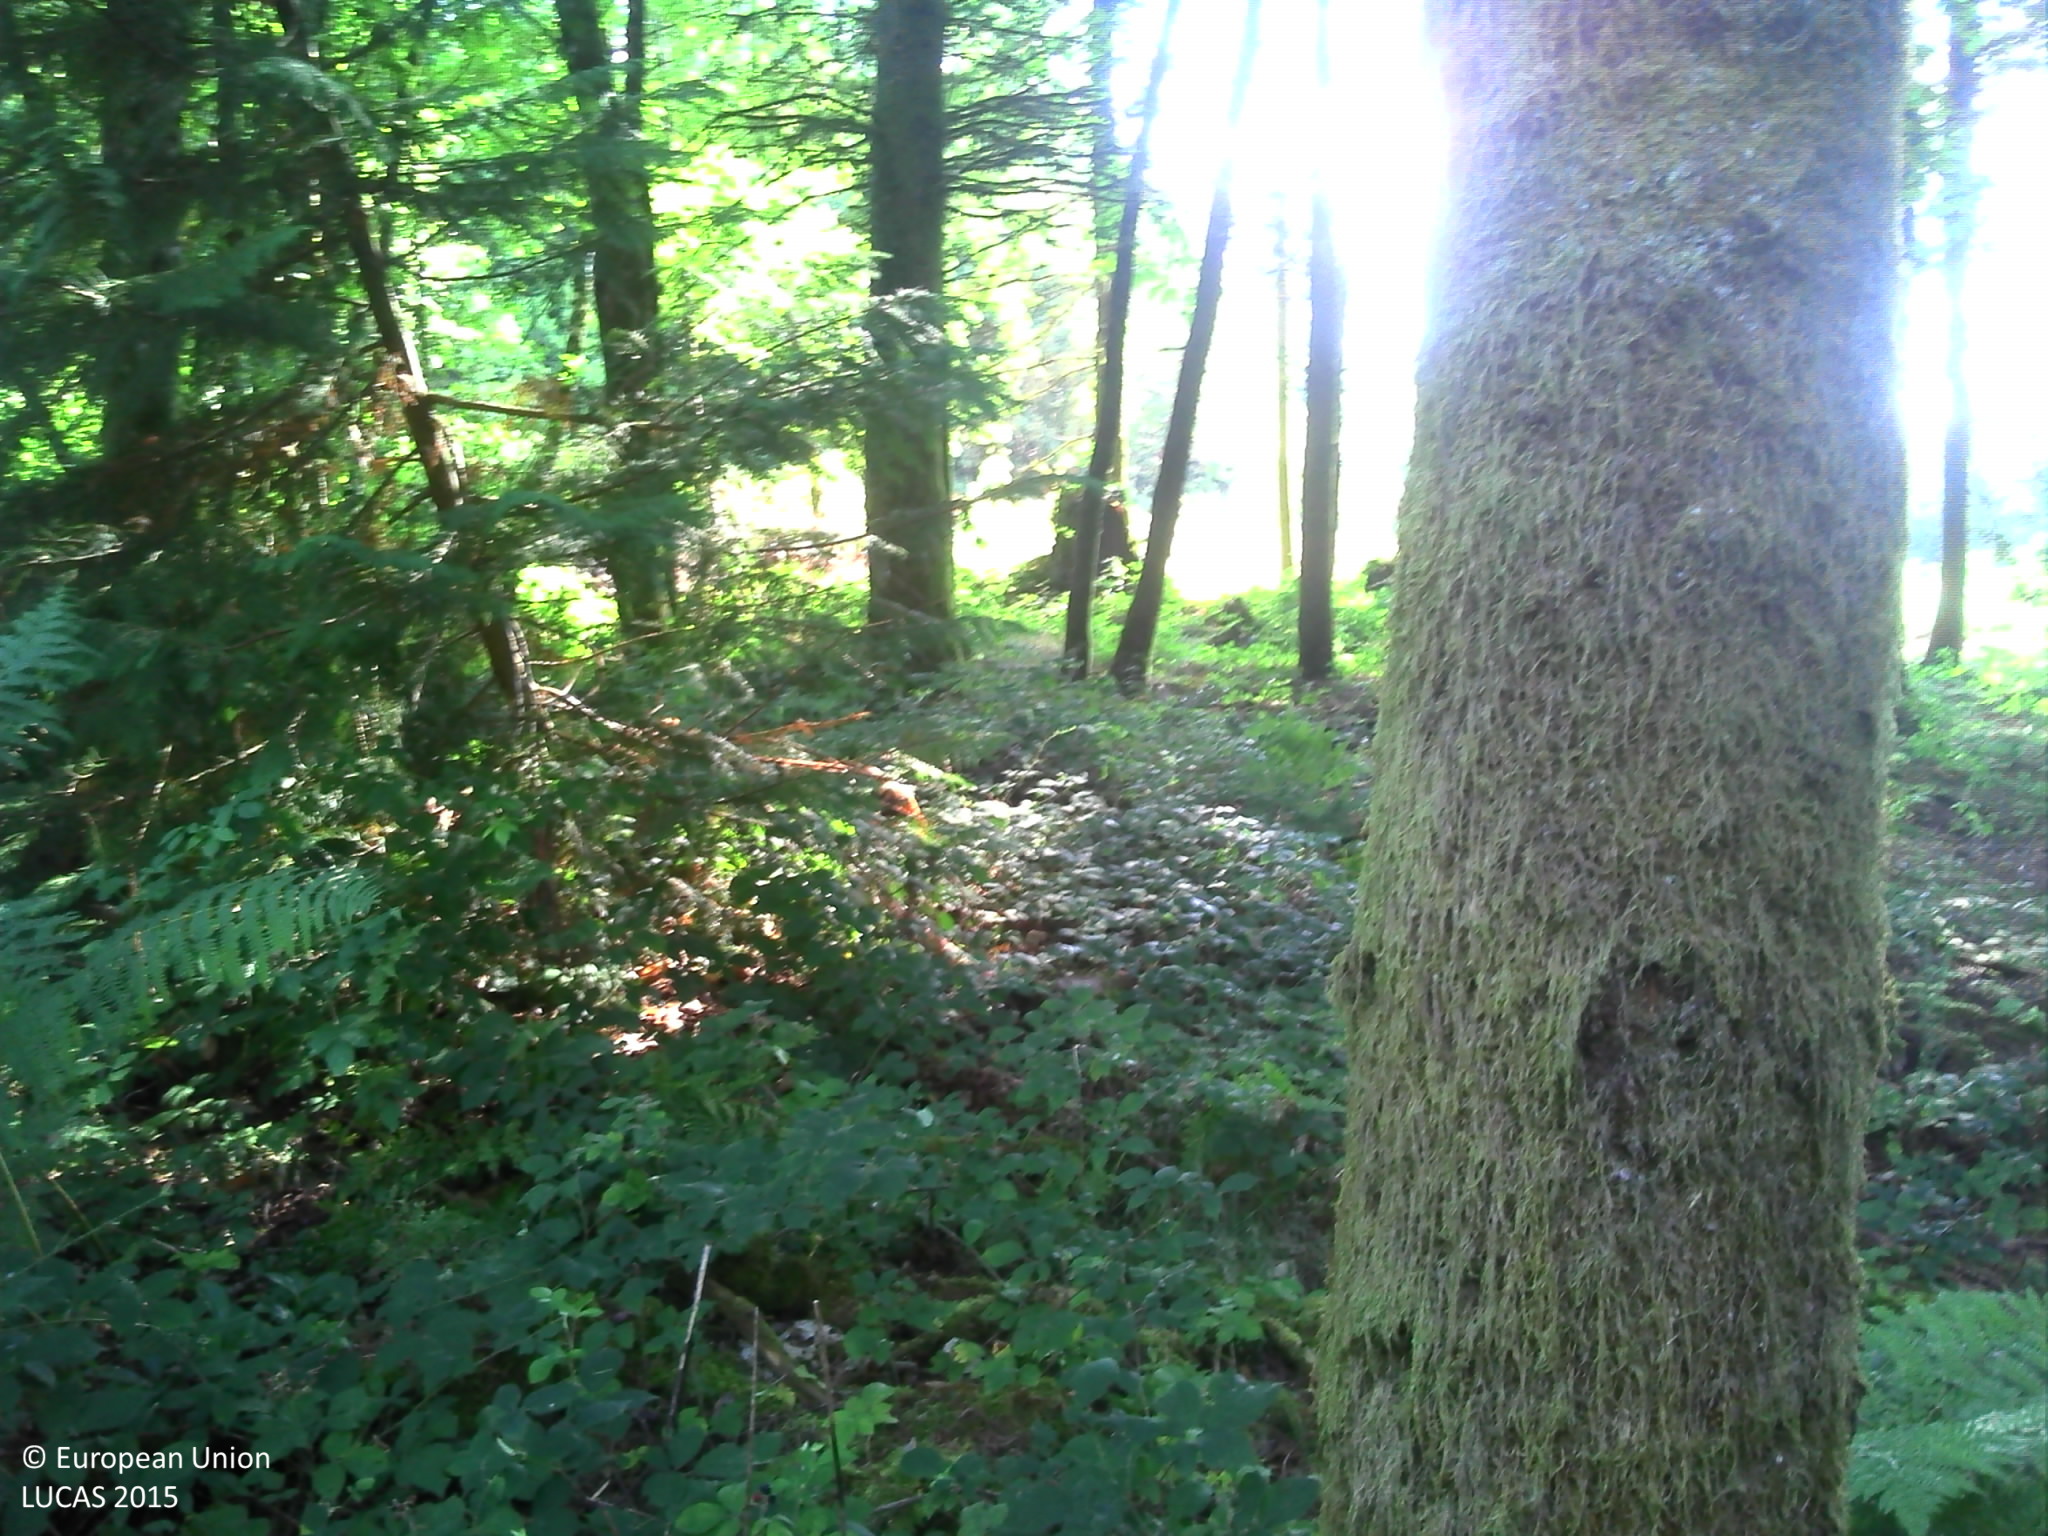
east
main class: Woodland
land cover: Spruce dominated coniferous woodland
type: hemiboreal forest and nemoral coniferous forest and mixed broadleaved-coniferous forest
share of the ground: > 75 %
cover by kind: coniferous forest trees 95 %, broadleaved forest trees 5 %
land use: Semi-natural and natural areas not in use
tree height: > 5 m
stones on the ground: < 10 %
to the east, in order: Spruce dominated coniferous woodland; Grass margins; Electric lines; Other bare soil; Shruby margins; Paved roads, cycling and walking lanes; Grass margins; Fences; Spruce dominated mixed woodland; Tracks; Spruce dominated mixed woodland
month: August
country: FR
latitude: 46.0046
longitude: 1.4035
